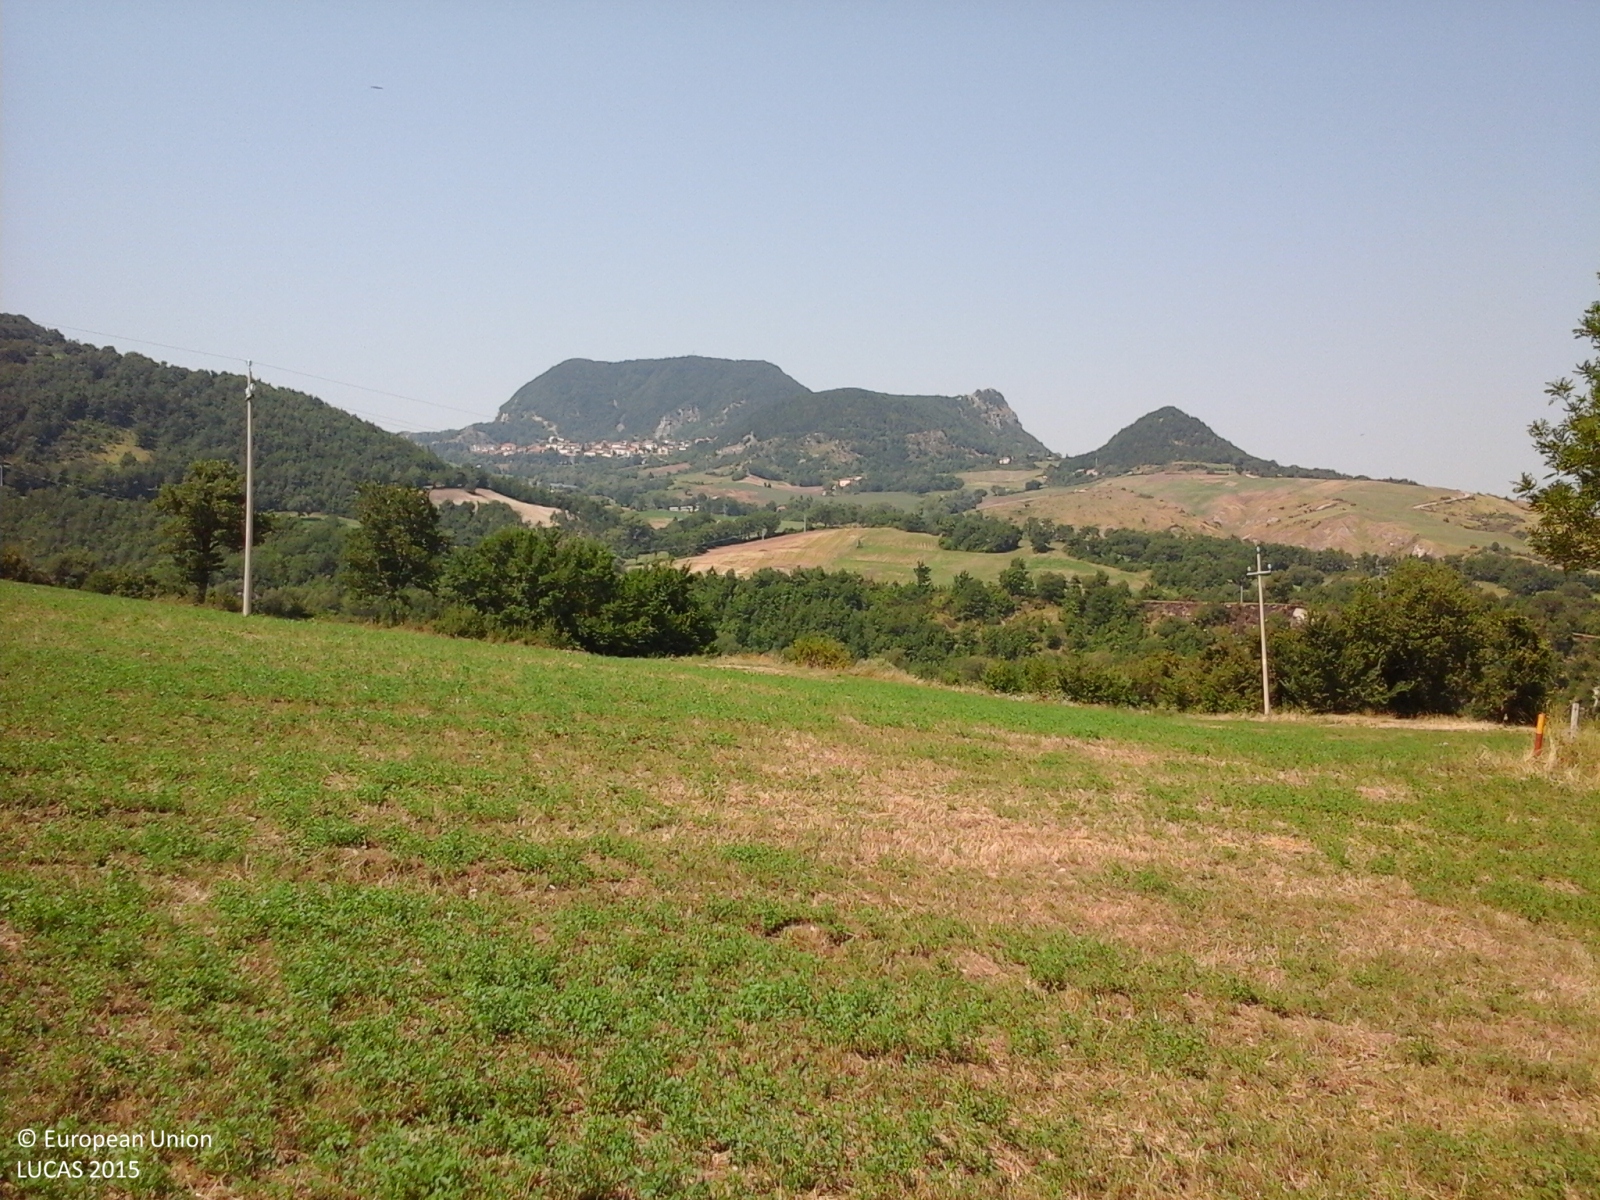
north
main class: Cropland
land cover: Lucerne
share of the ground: > 75 %
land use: Agriculture (excluding fallow land and kitchen gardens)
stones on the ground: < 10 %
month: August
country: IT
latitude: 43.8182
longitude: 12.3689
